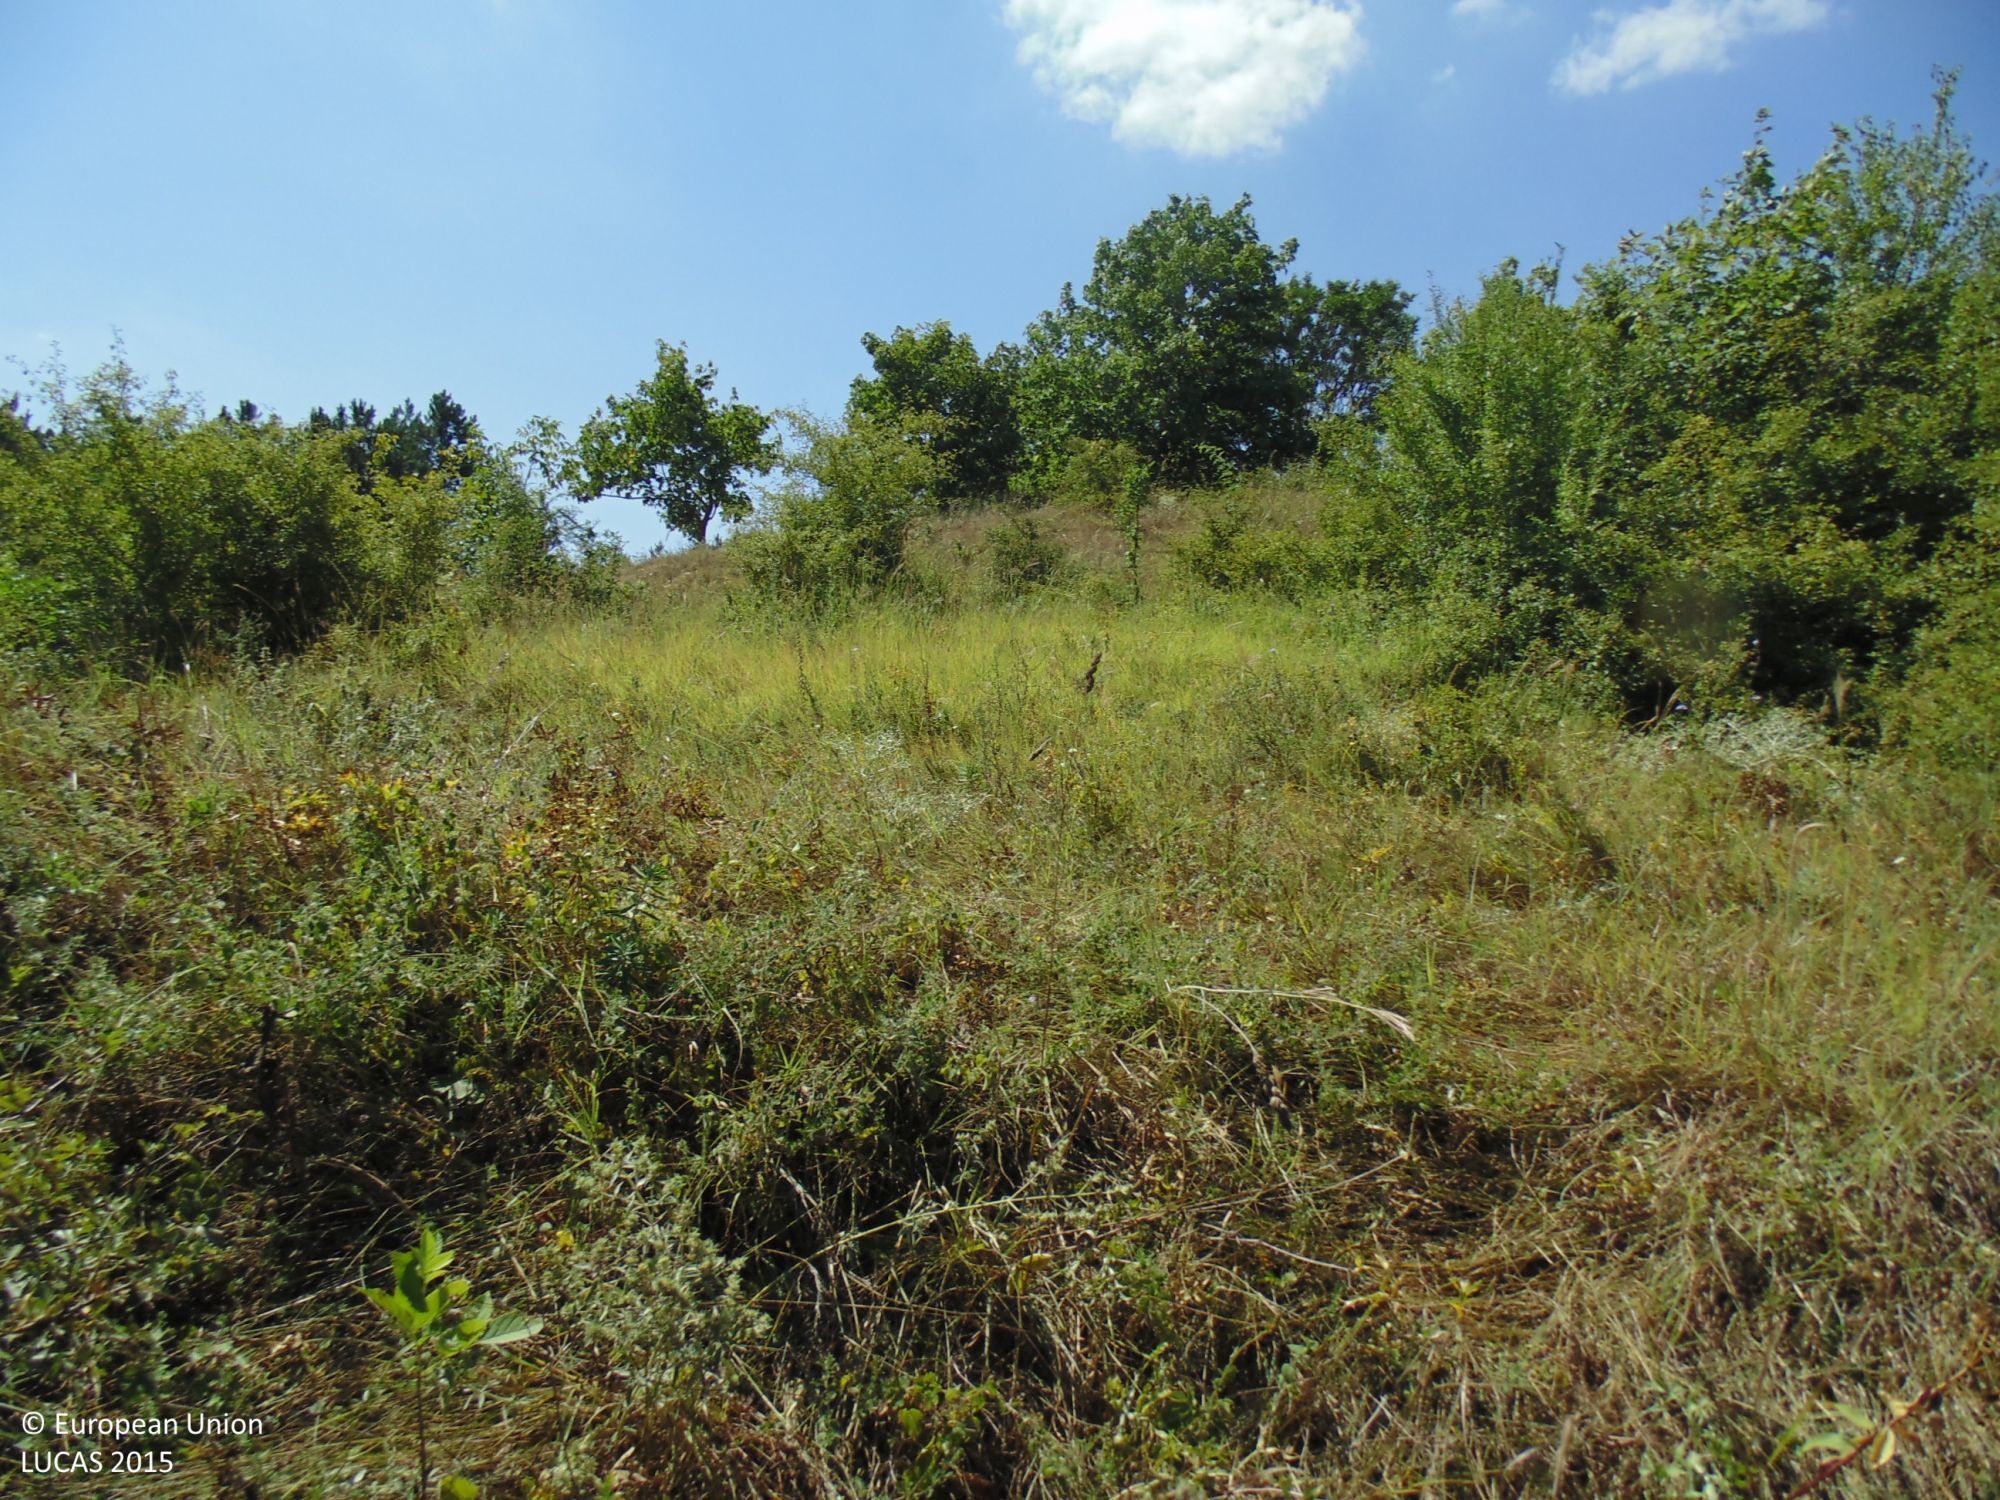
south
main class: Woodland
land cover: Broadleaved woodland
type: mesophytic deciduous forest
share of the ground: 25 - 50 %
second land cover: Grassland without tree/shrub cover
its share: > 75 %
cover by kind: herbaceous plants 70 %, broadleaved forest trees 25 %, shrubs 5 %
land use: Forestry
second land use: Agriculture (excluding fallow land and kitchen gardens)
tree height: < 5 m
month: August
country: BG
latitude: 43.6397
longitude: 28.1383
